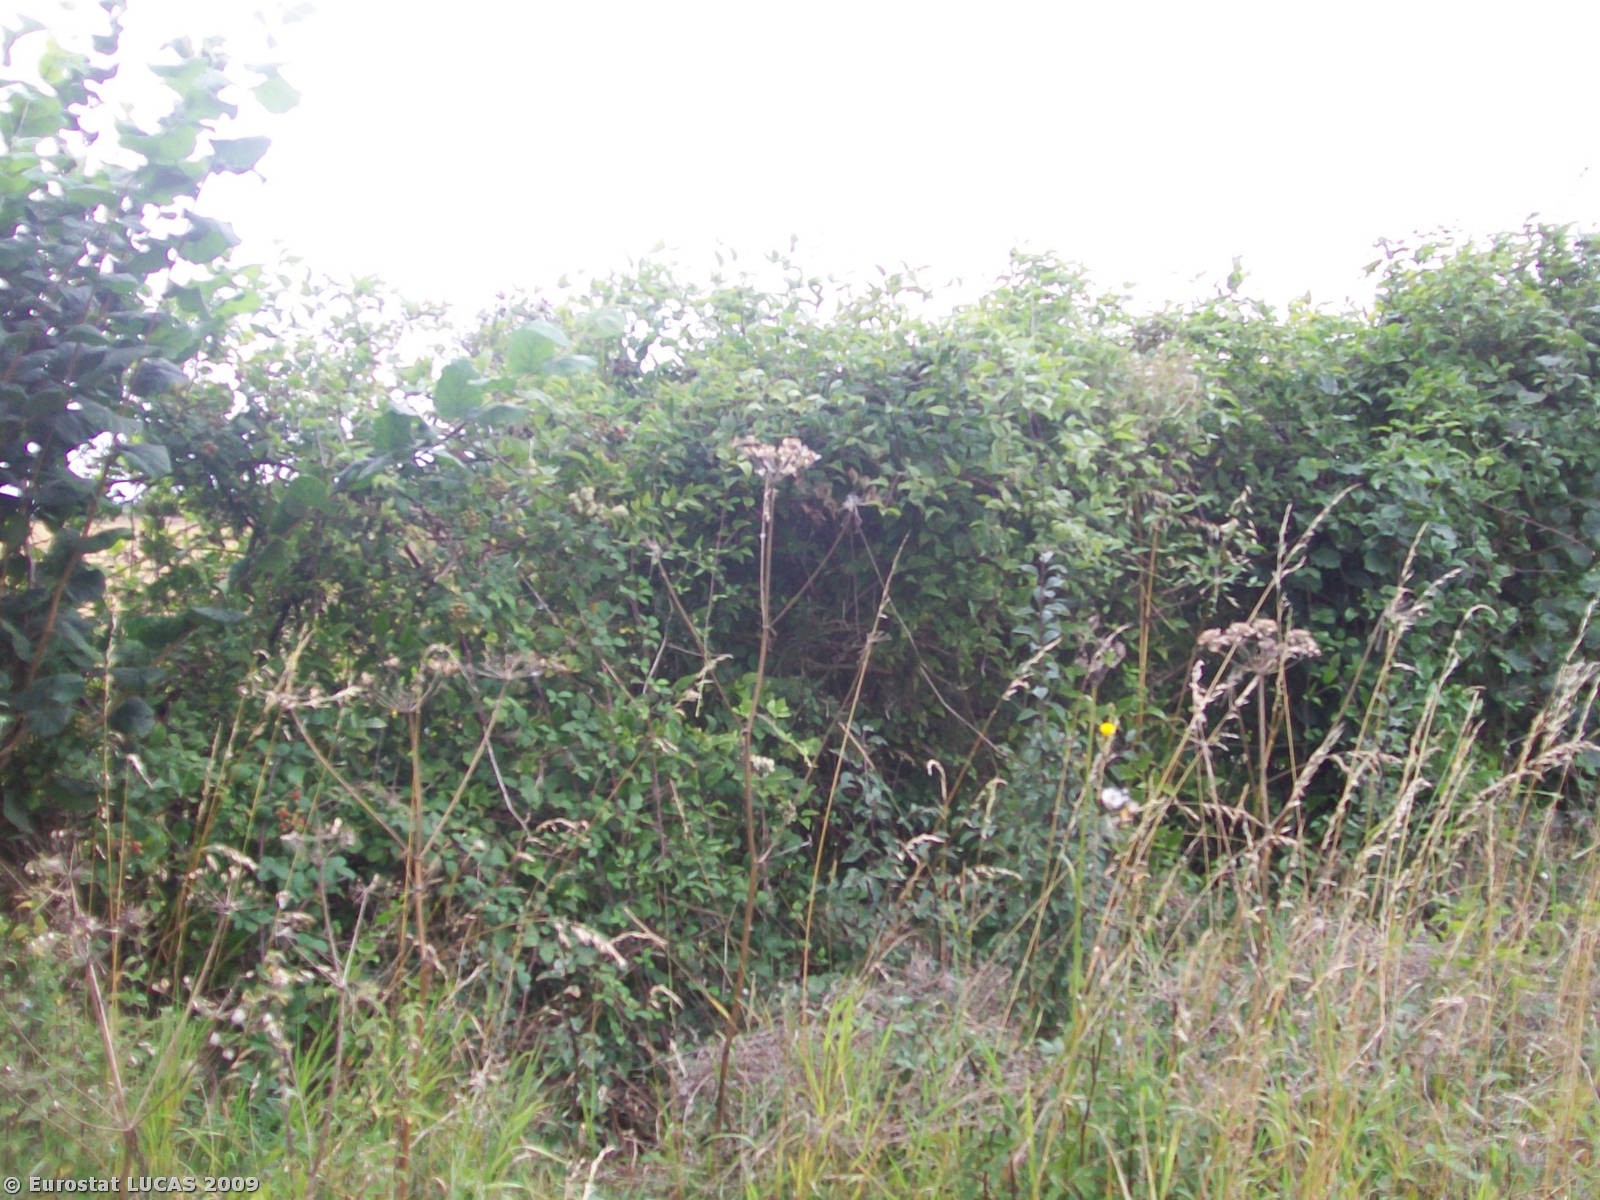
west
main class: Cropland
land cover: Dry pulses
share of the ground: > 75 %
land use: Agriculture (excluding fallow land and kitchen gardens)
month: August
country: GB
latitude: 51.8015
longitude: 0.1219
